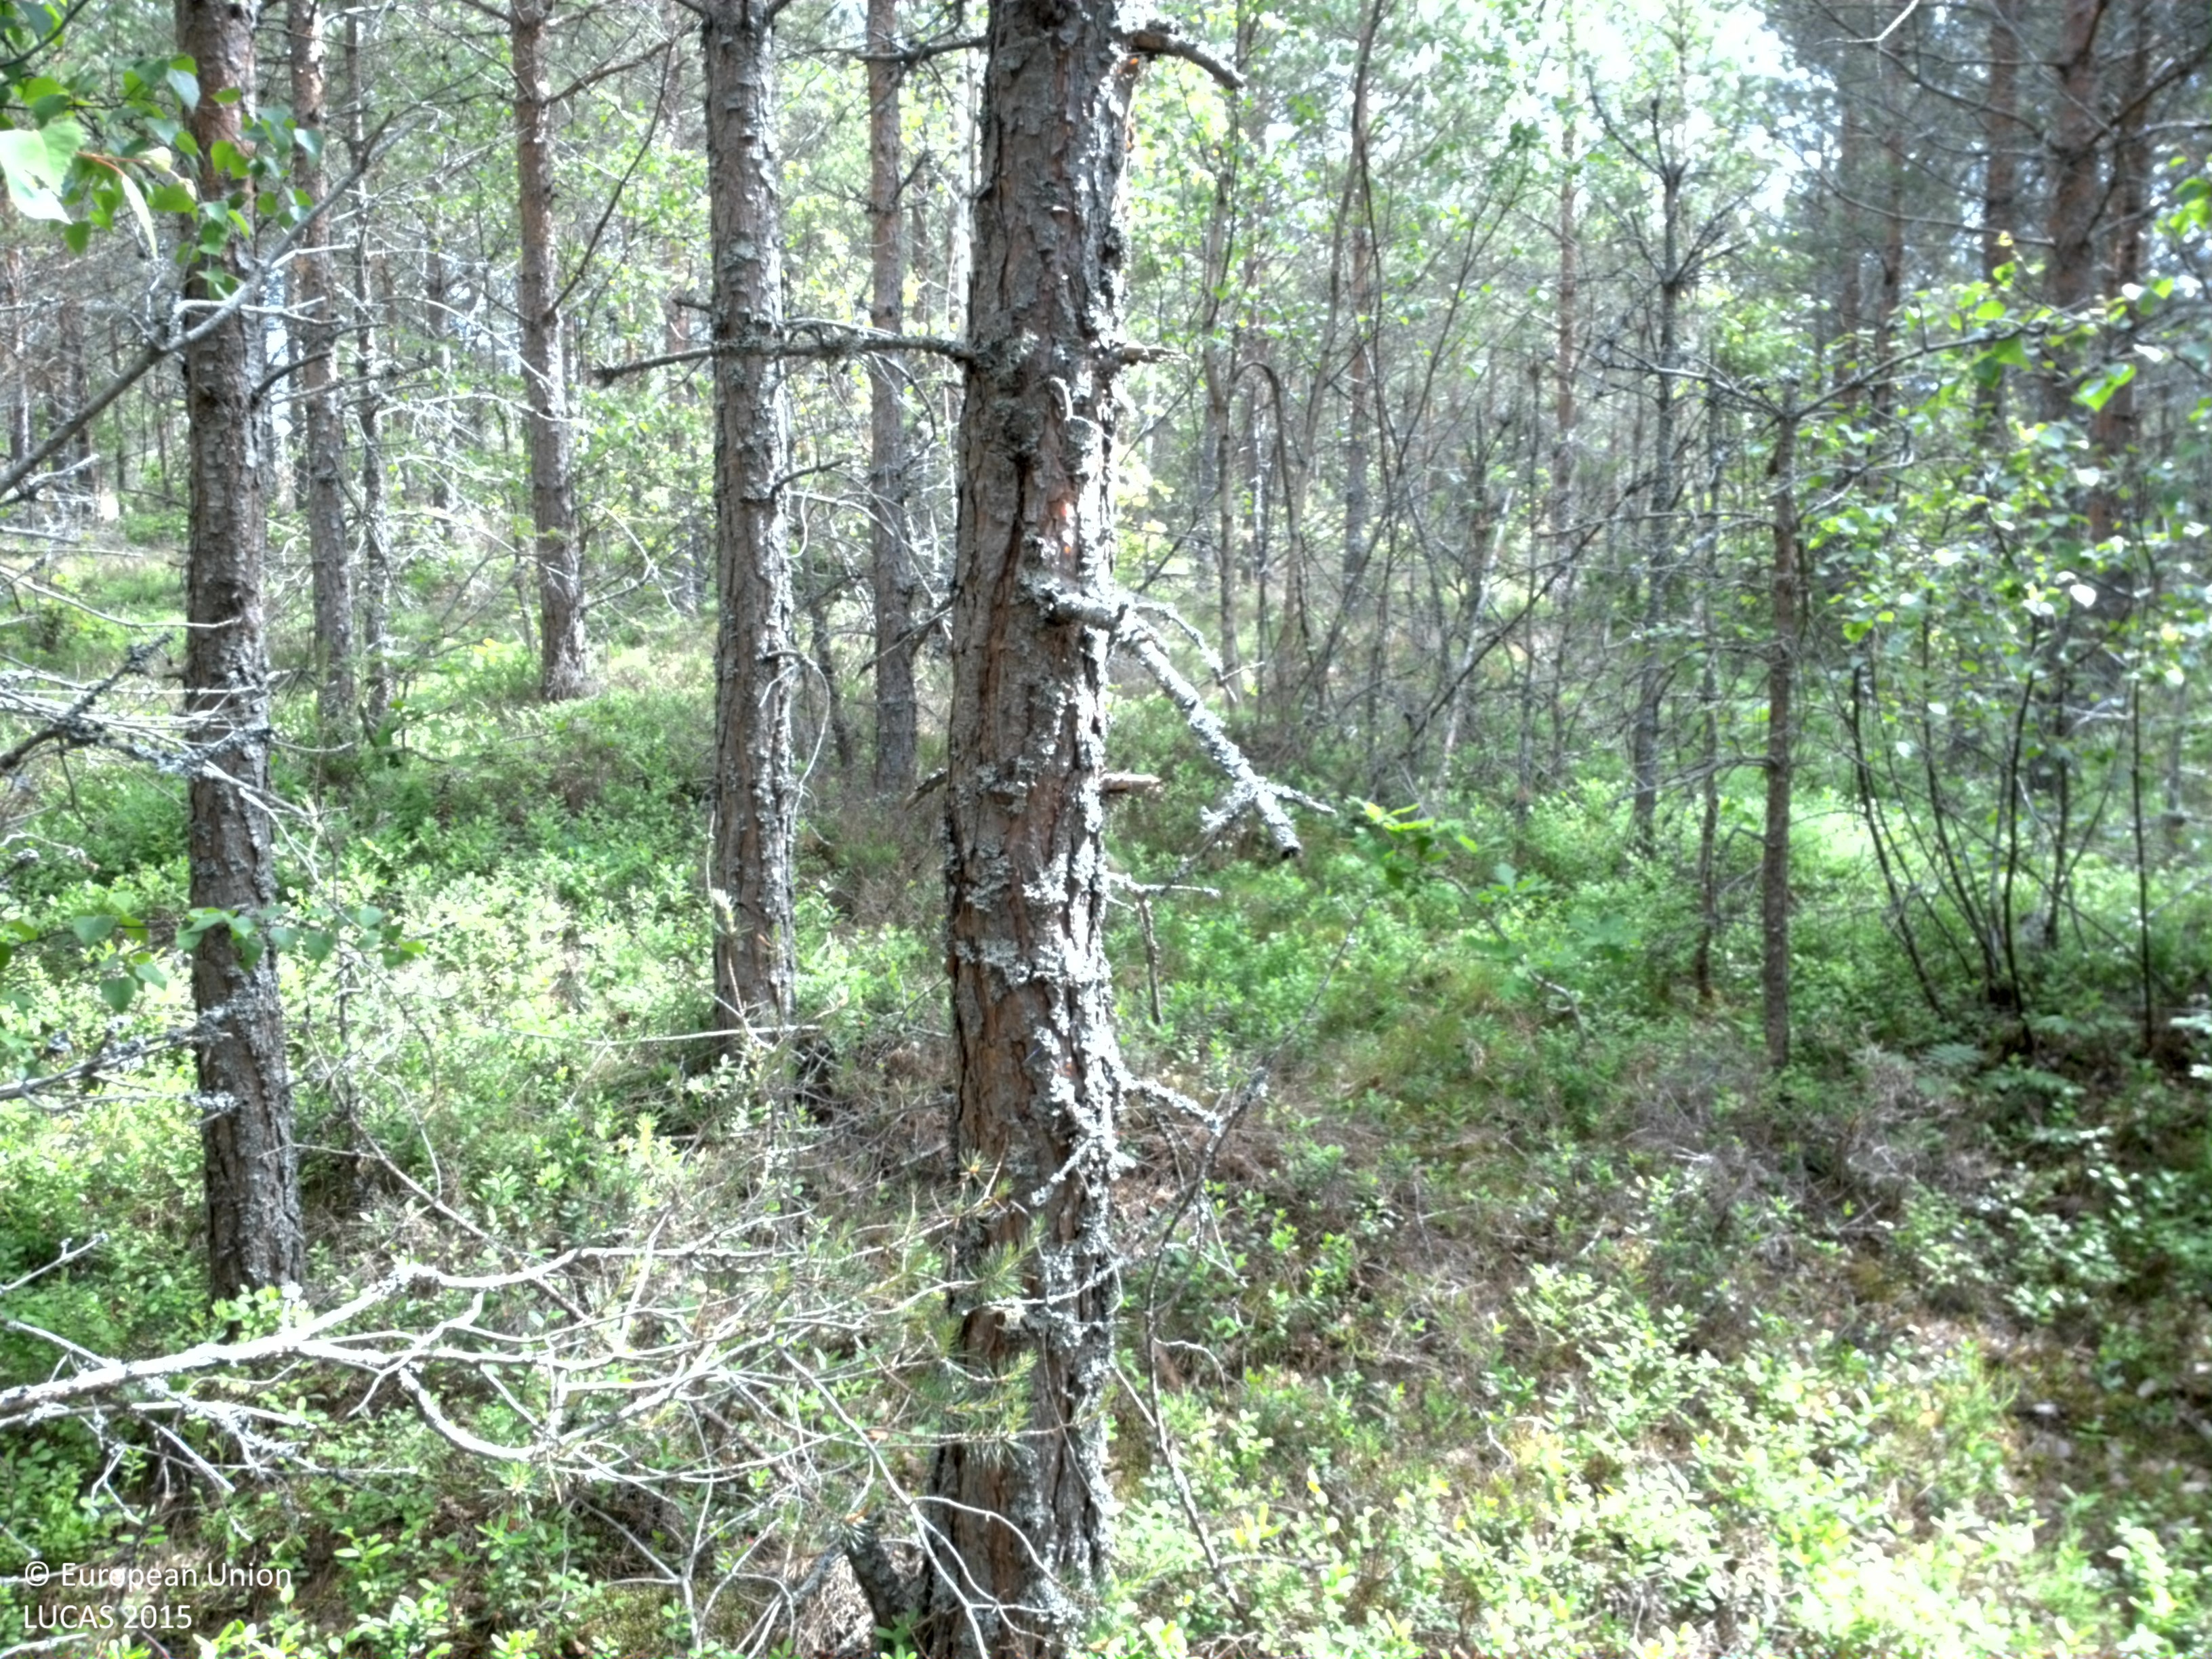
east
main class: Woodland
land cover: Pine dominated coniferous woodland
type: boreal forest
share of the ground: 25 - 50 %
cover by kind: coniferous forest trees 40 %, herbaceous plants 40 %, lichens and mosses 15 %, broadleaved forest trees 5 %
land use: Forestry
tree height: < 5 m
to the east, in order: Pine dominated coniferous woodland; Rock outcrops; Pine dominated coniferous woodland; Rock outcrops; Pine dominated coniferous woodland; Spruce dominated mixed woodland; Ditches and canals; Fences; Grassland without tree/shrub cover
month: June
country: SE
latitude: 58.5295
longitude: 16.1605
